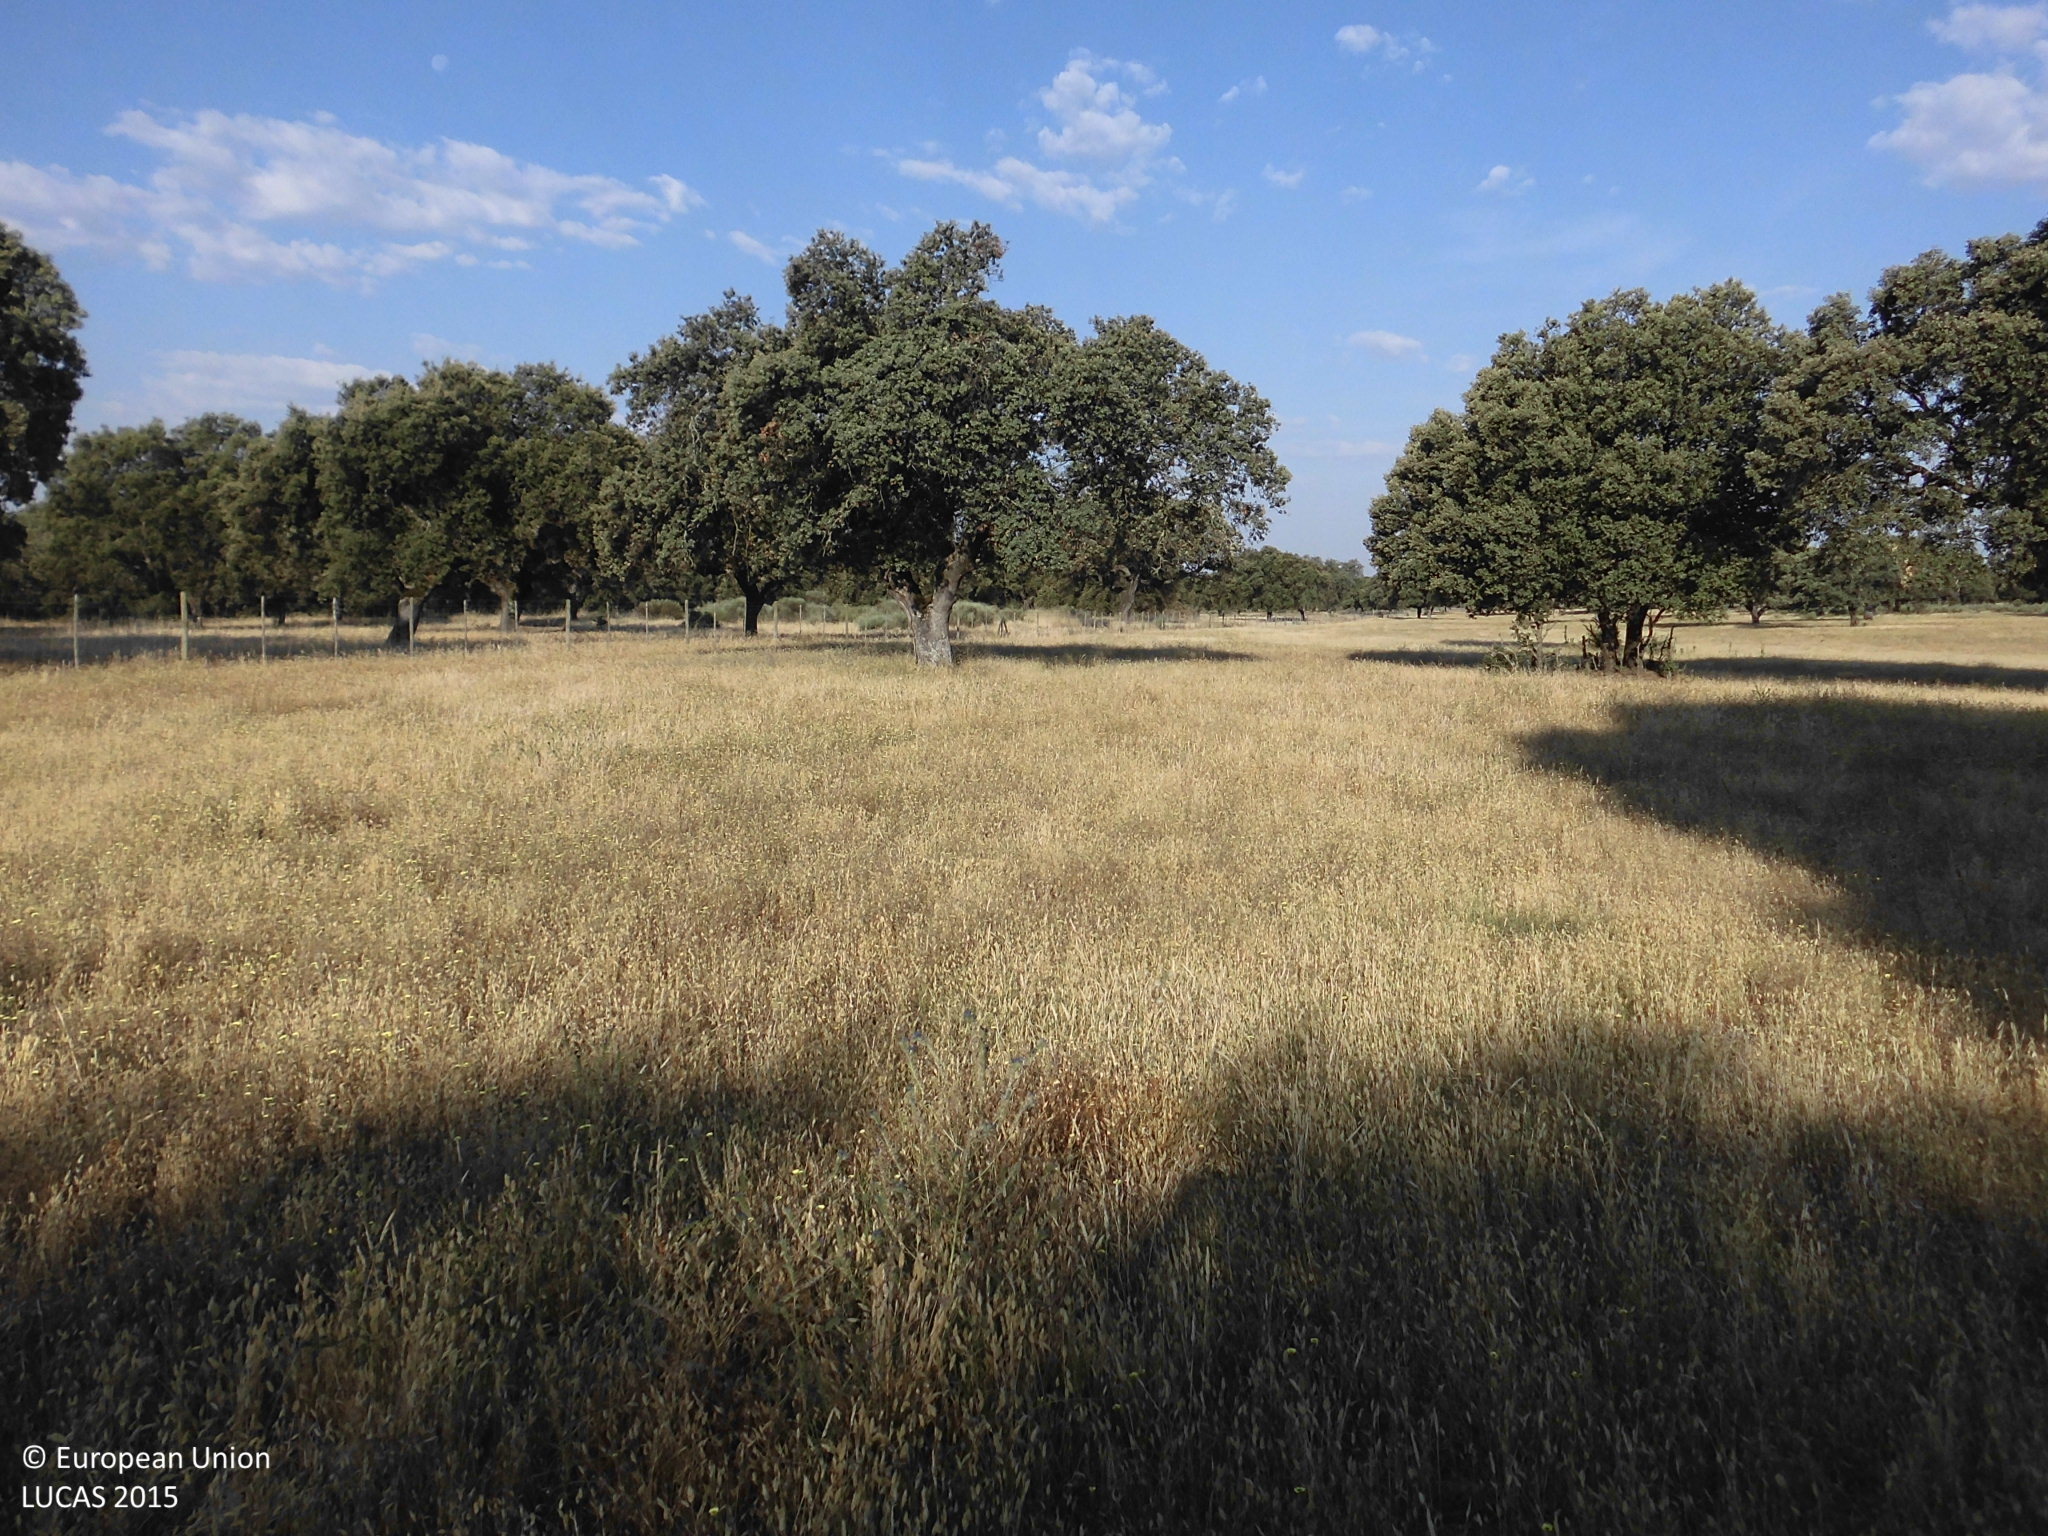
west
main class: Woodland
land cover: Broadleaved woodland
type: broadleaved evergreen forest
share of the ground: 10 - 25 %
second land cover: Grassland without tree/shrub cover
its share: > 75 %
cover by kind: herbaceous plants 80 %, broadleaved forest trees 20 %
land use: Forestry
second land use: Agriculture (excluding fallow land and kitchen gardens)
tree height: > 5 m
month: June
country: ES
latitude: 39.9791
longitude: -5.4093
